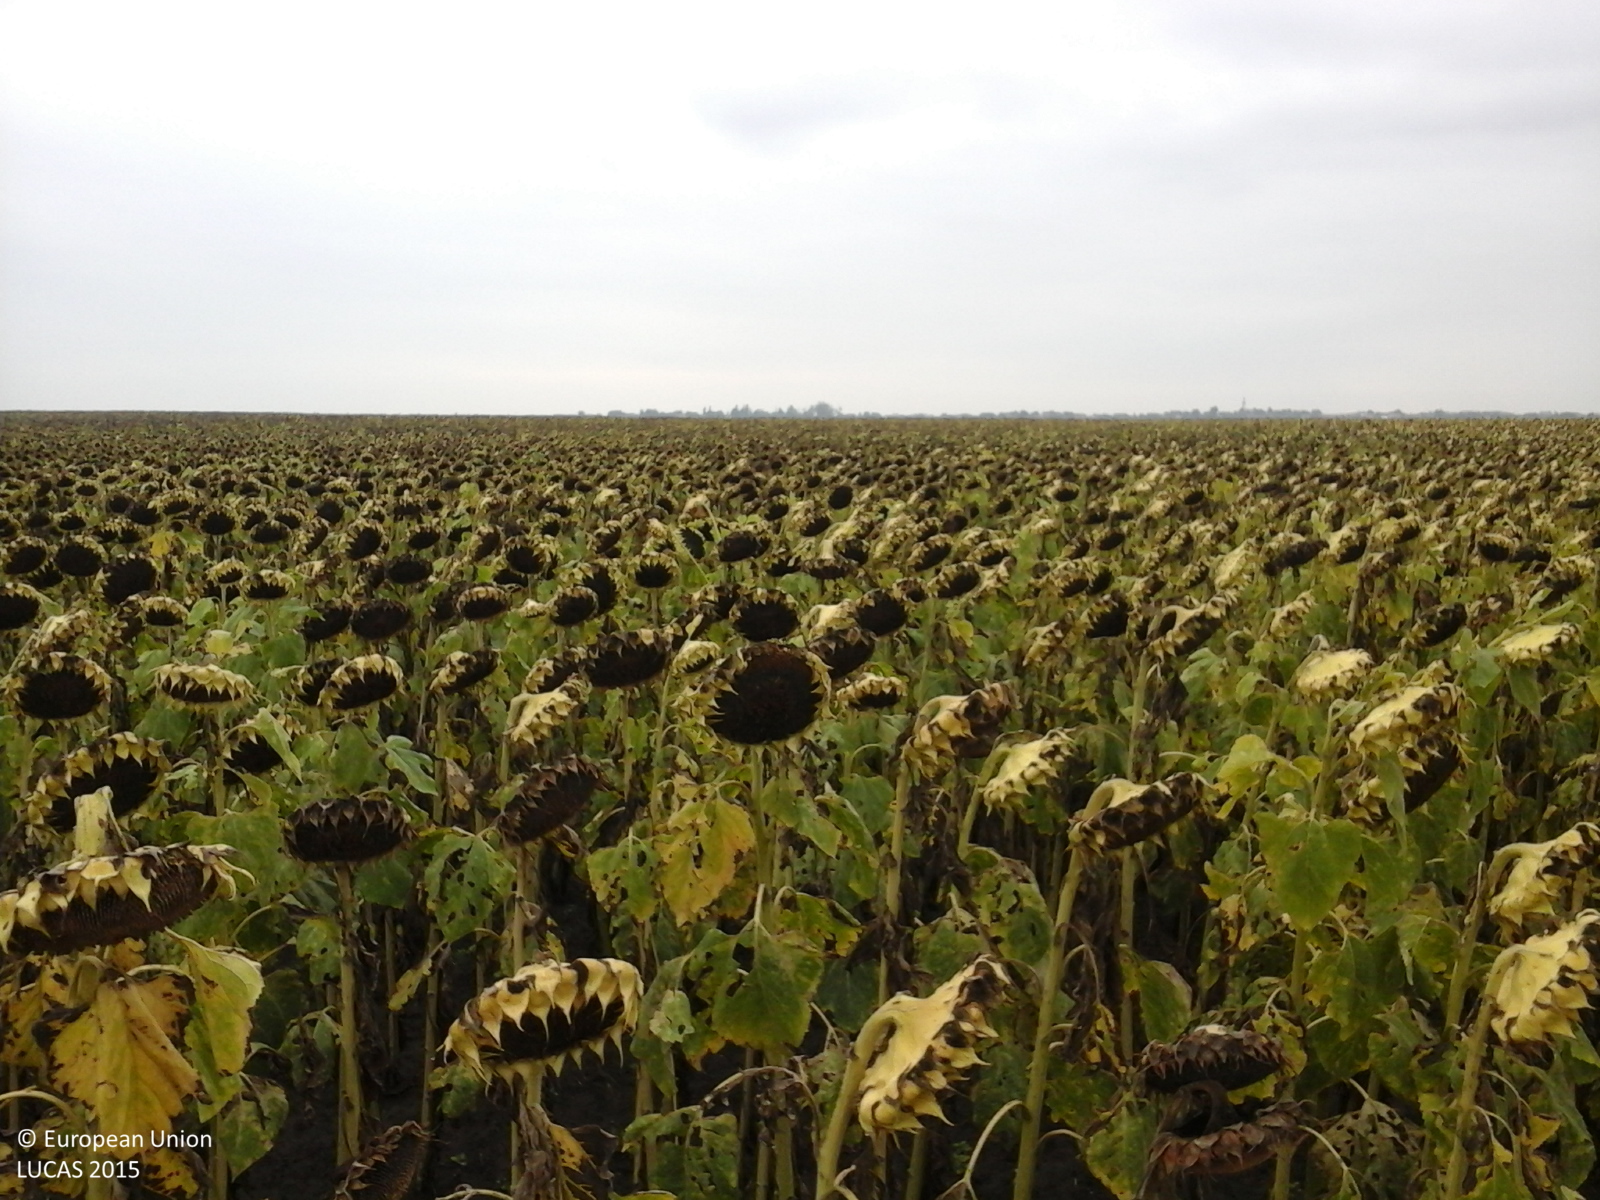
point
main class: Cropland
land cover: Sunflower
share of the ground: > 75 %
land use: Agriculture (excluding fallow land and kitchen gardens)
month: August
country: RO
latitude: 45.6344
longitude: 21.0214
